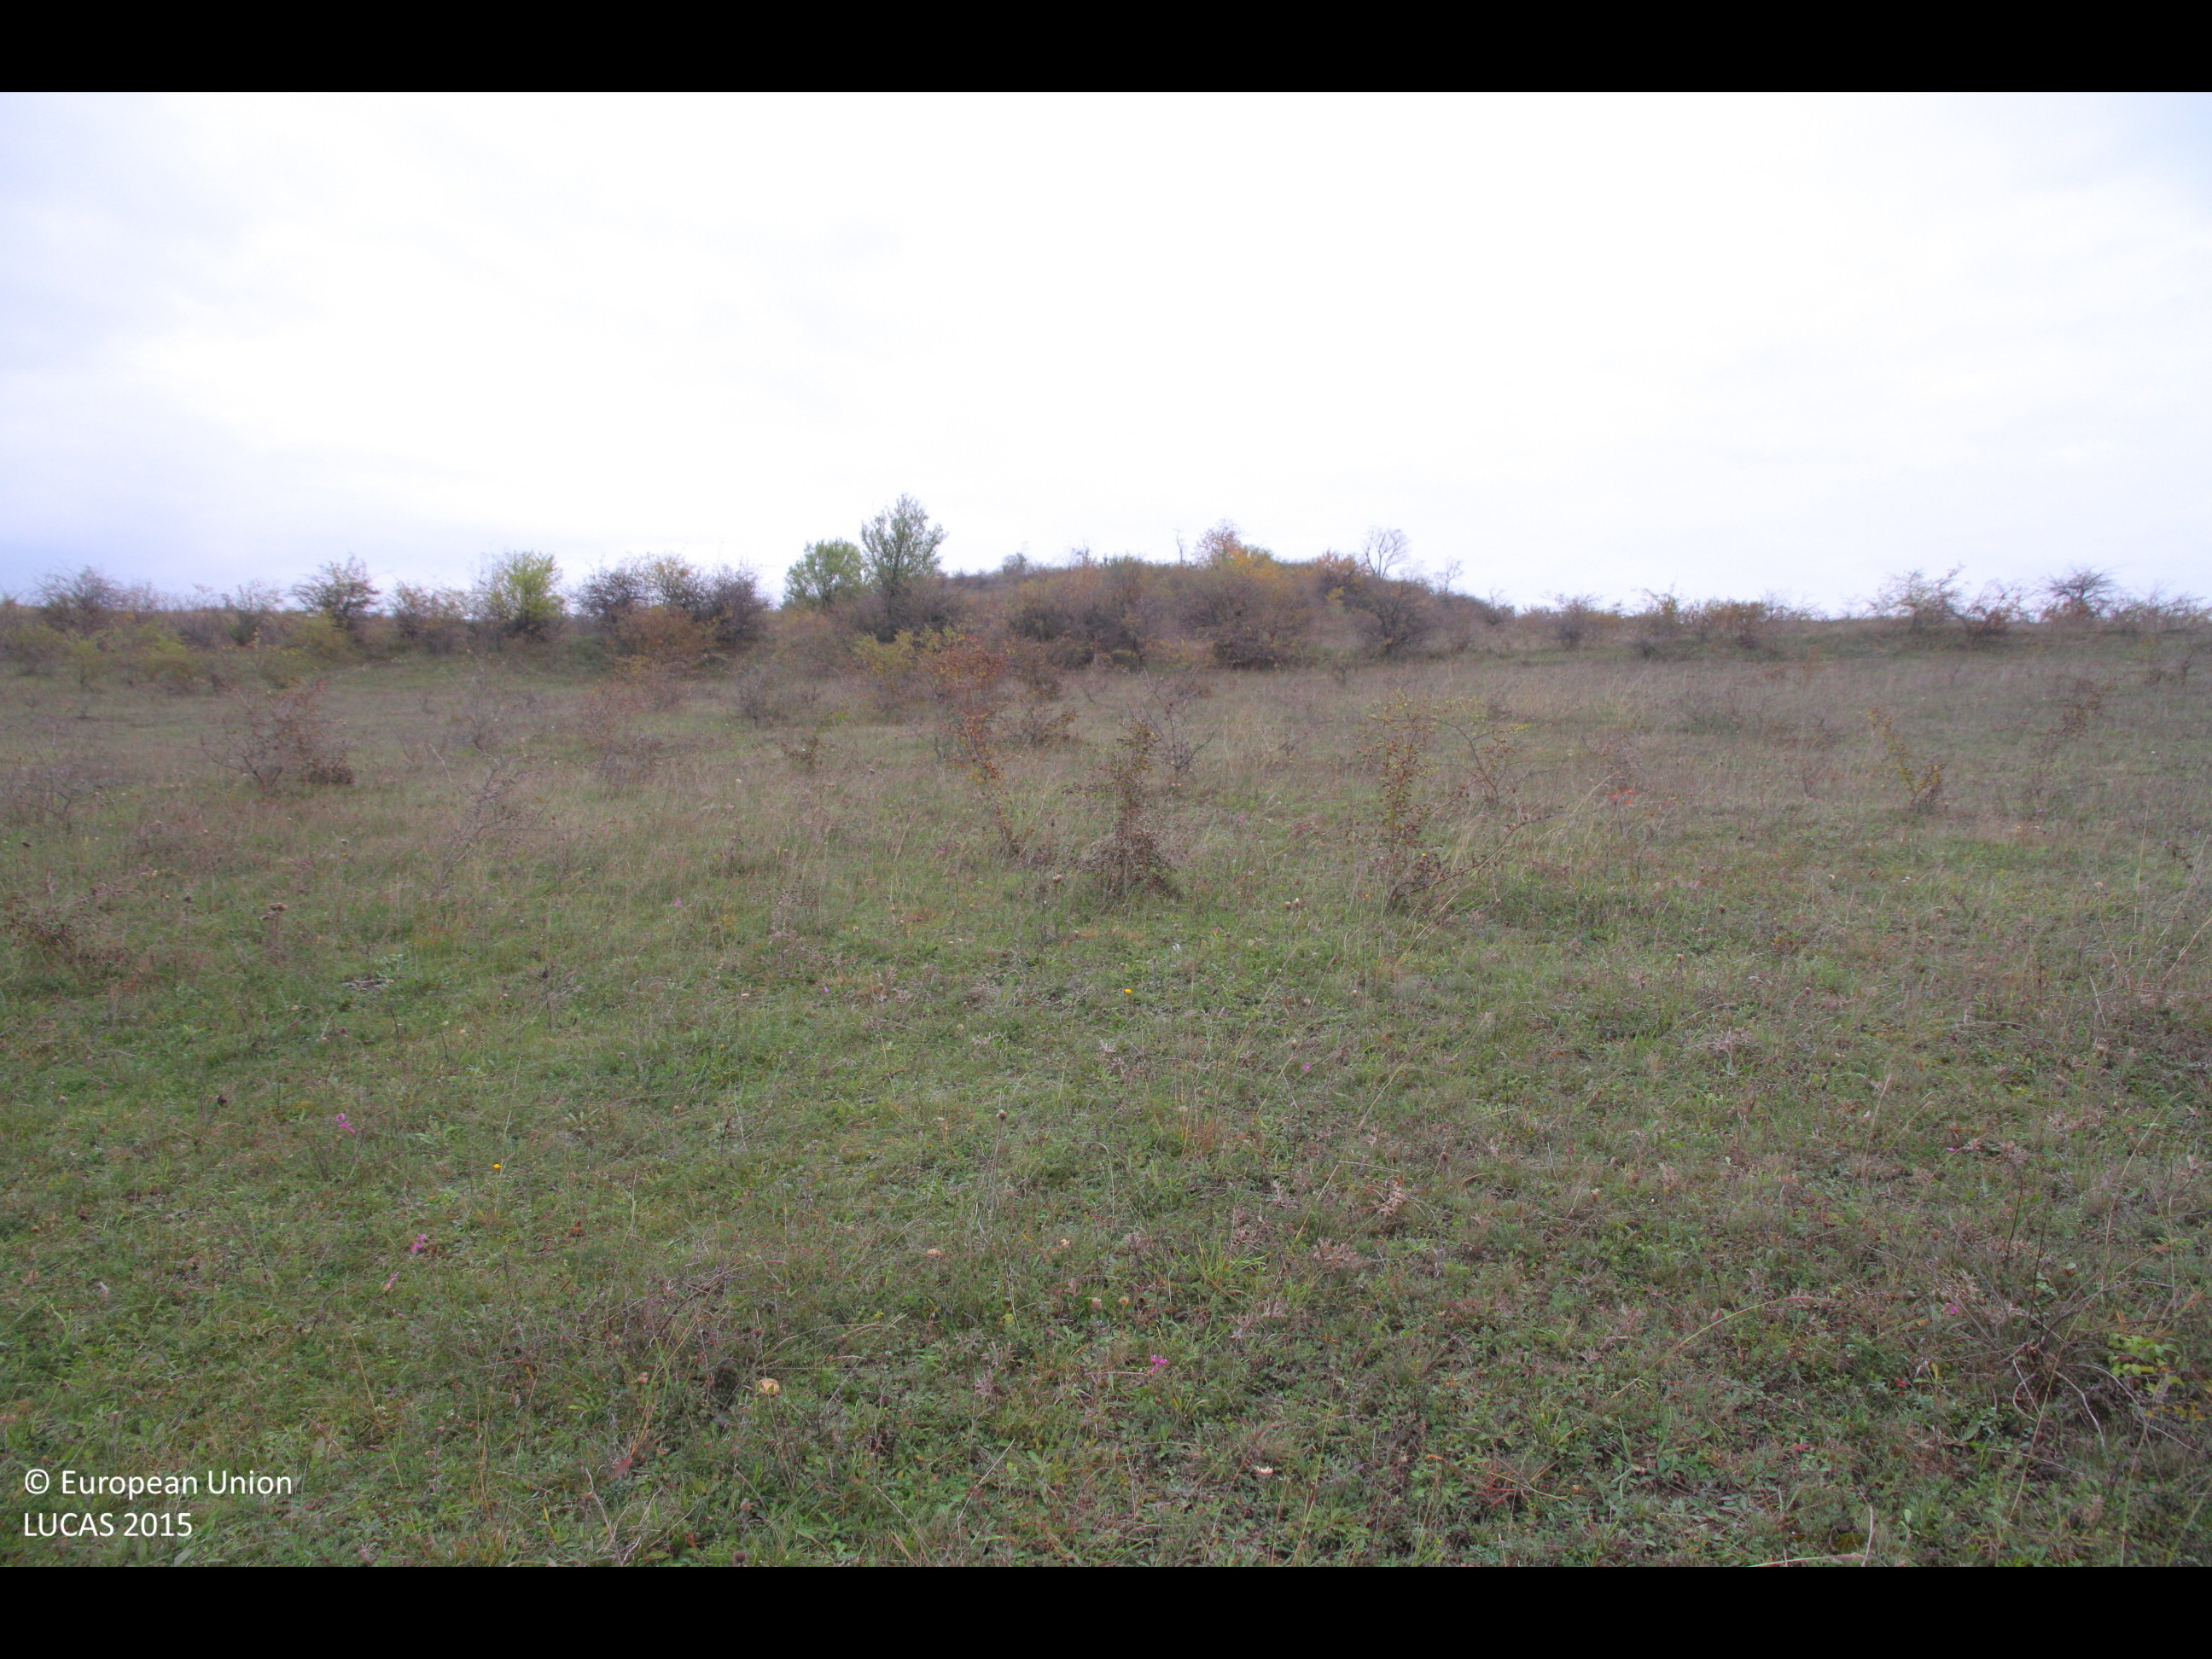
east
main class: Grassland
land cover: Grassland with sparse tree/shrub cover
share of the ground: > 75 %
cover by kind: herbaceous plants 85 %, shrubs 10 %, broadleaved forest trees 5 %
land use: Agriculture (excluding fallow land and kitchen gardens)
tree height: < 5 m
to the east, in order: Grassland with sparse tree/shrub cover; Abandoned hedges; Grassland with sparse tree/shrub cover
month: October
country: BG
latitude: 43.4207
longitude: 26.8485
